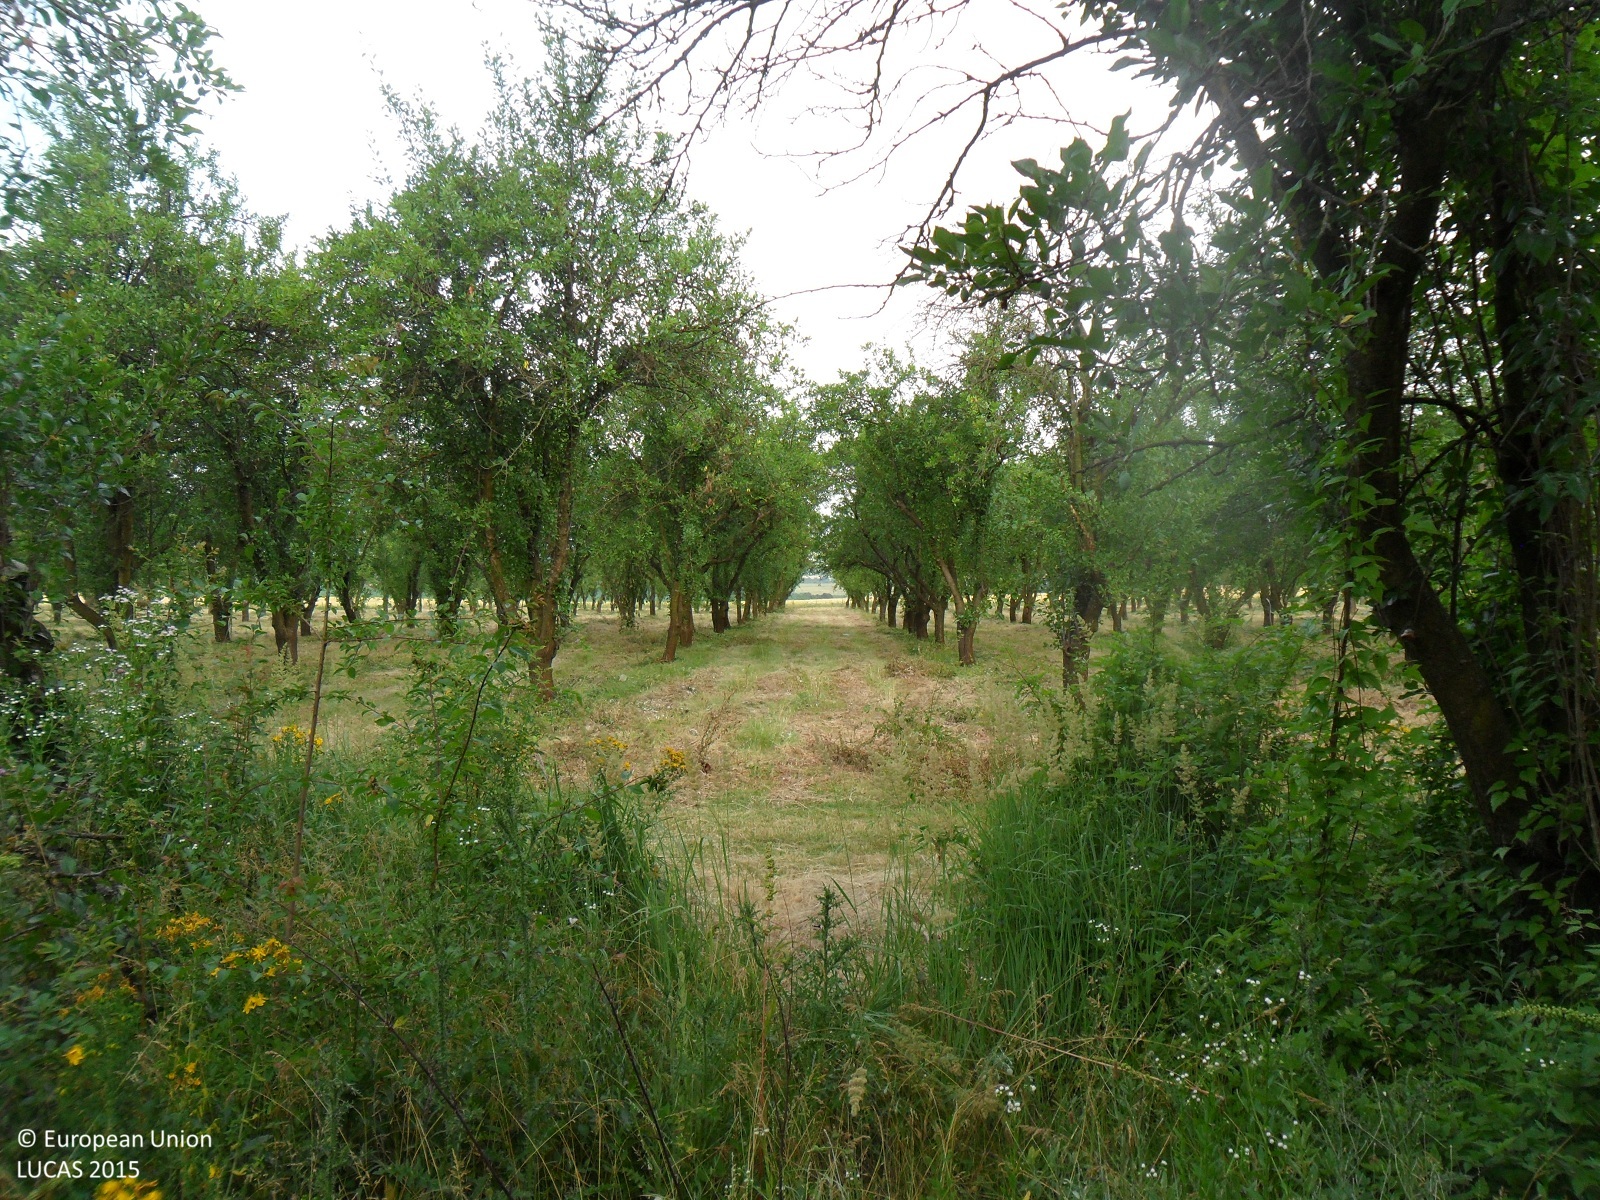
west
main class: Cropland
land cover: Other fruit trees and berries
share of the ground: 50 - 75 %
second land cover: Spontaneously vegetated surfaces
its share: > 75 %
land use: Agriculture (excluding fallow land and kitchen gardens)
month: June
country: BG
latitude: 43.7564
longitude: 26.8209
